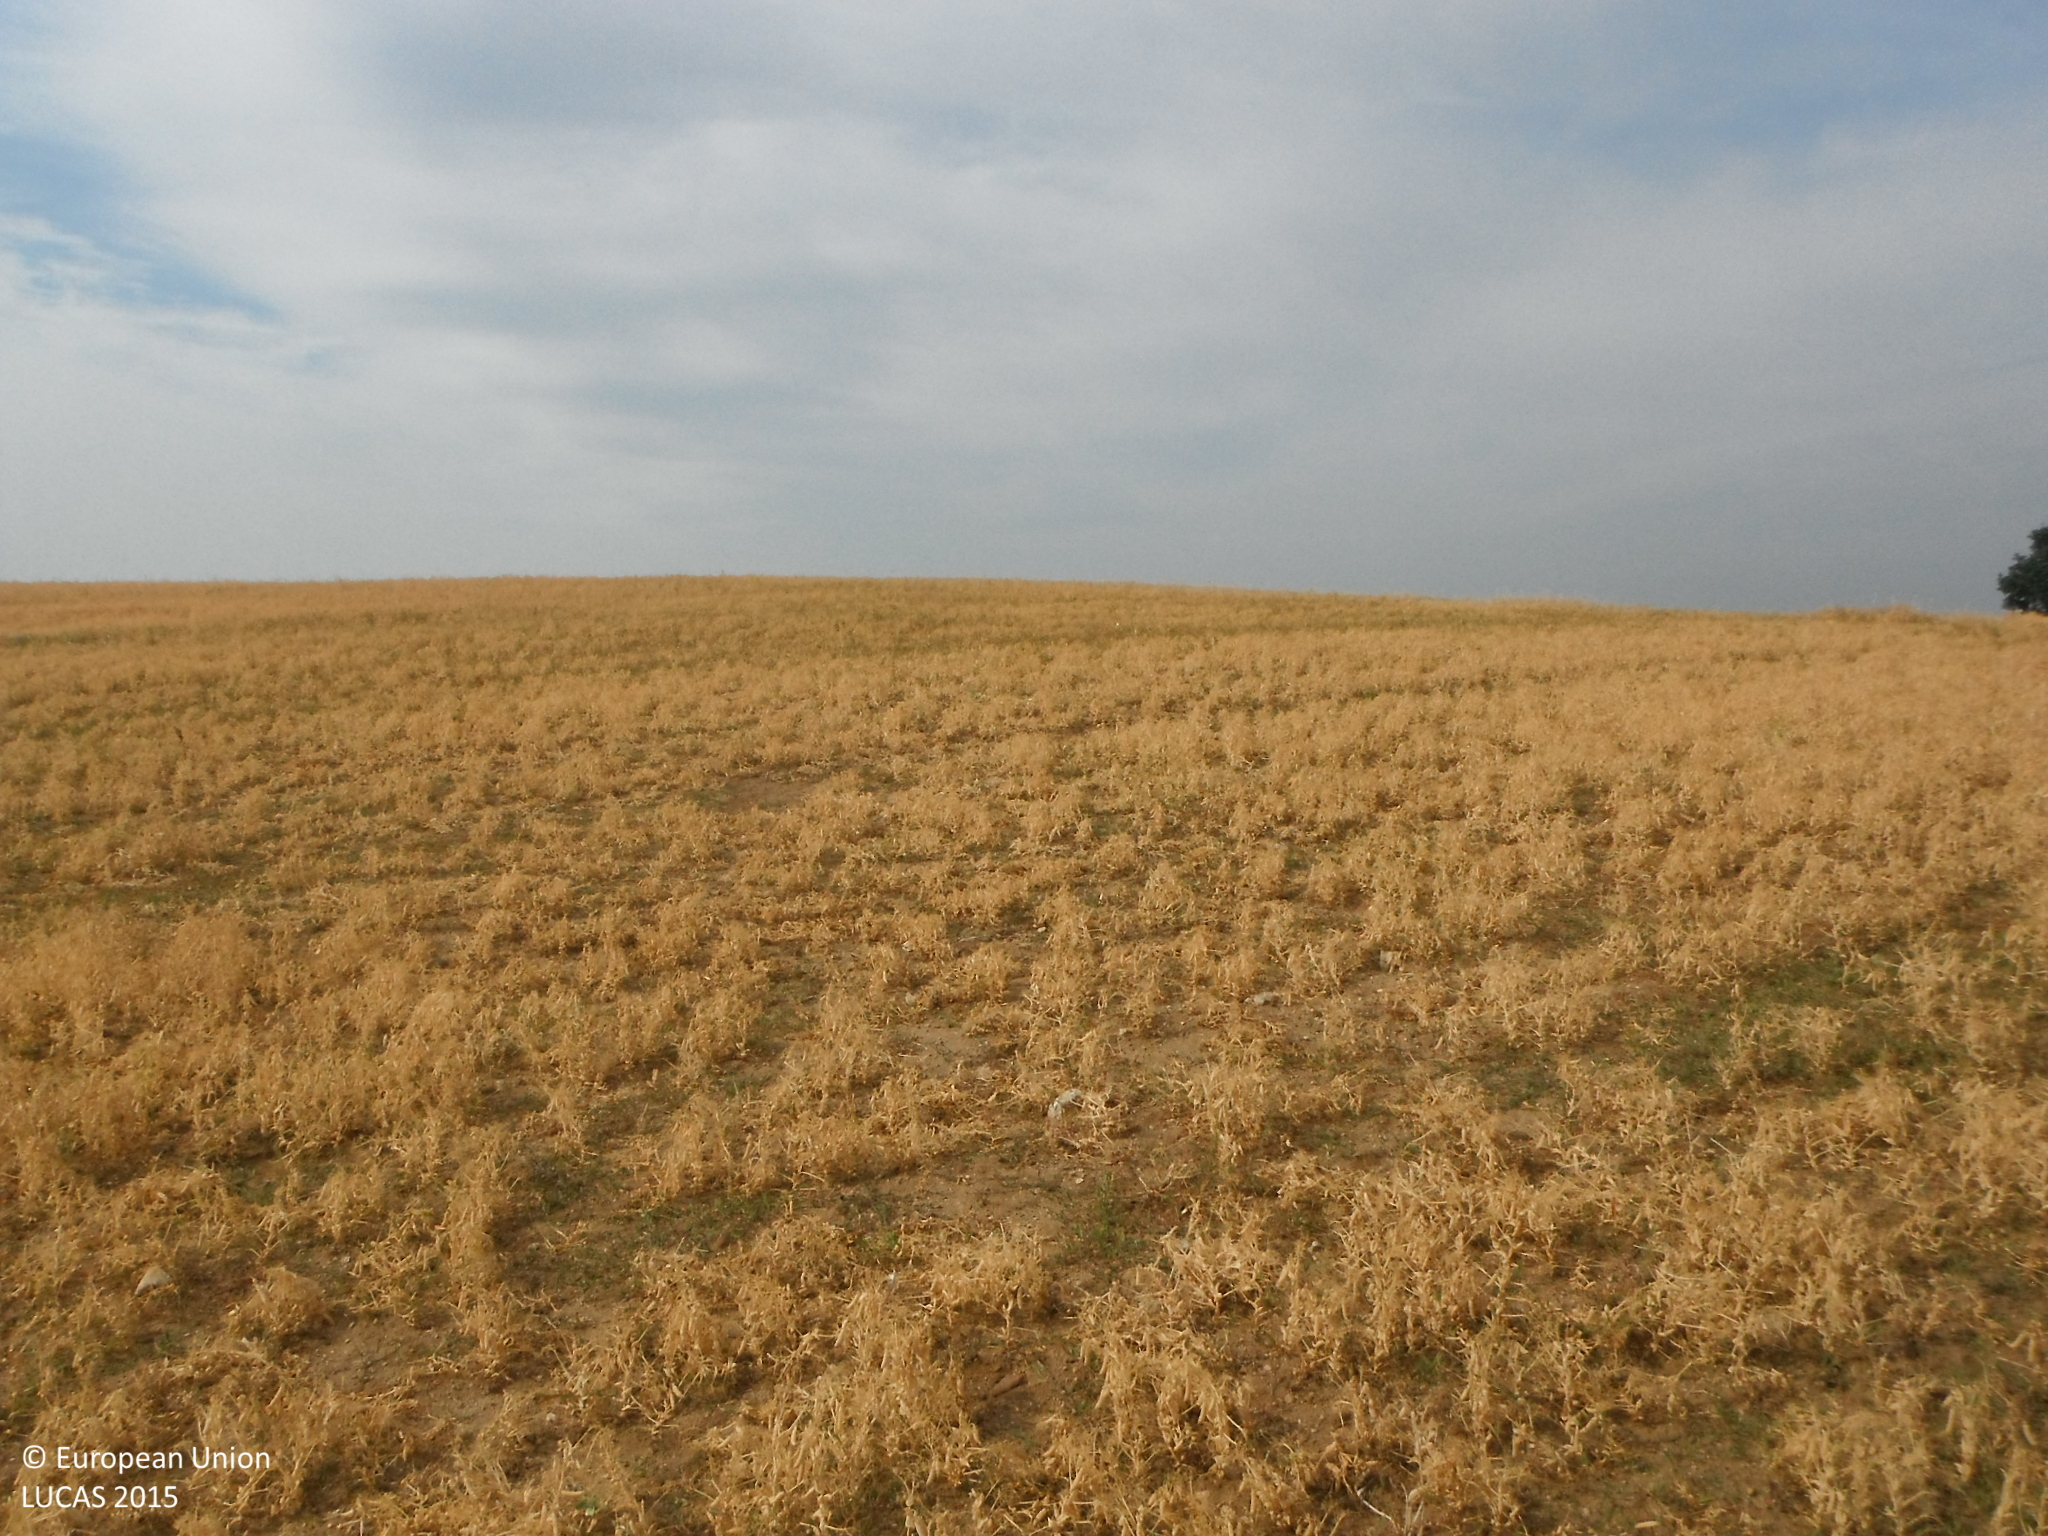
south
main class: Cropland
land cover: Dry pulses
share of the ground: > 75 %
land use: Agriculture (excluding fallow land and kitchen gardens)
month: June
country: SK
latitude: 48.3646
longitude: 17.7731
